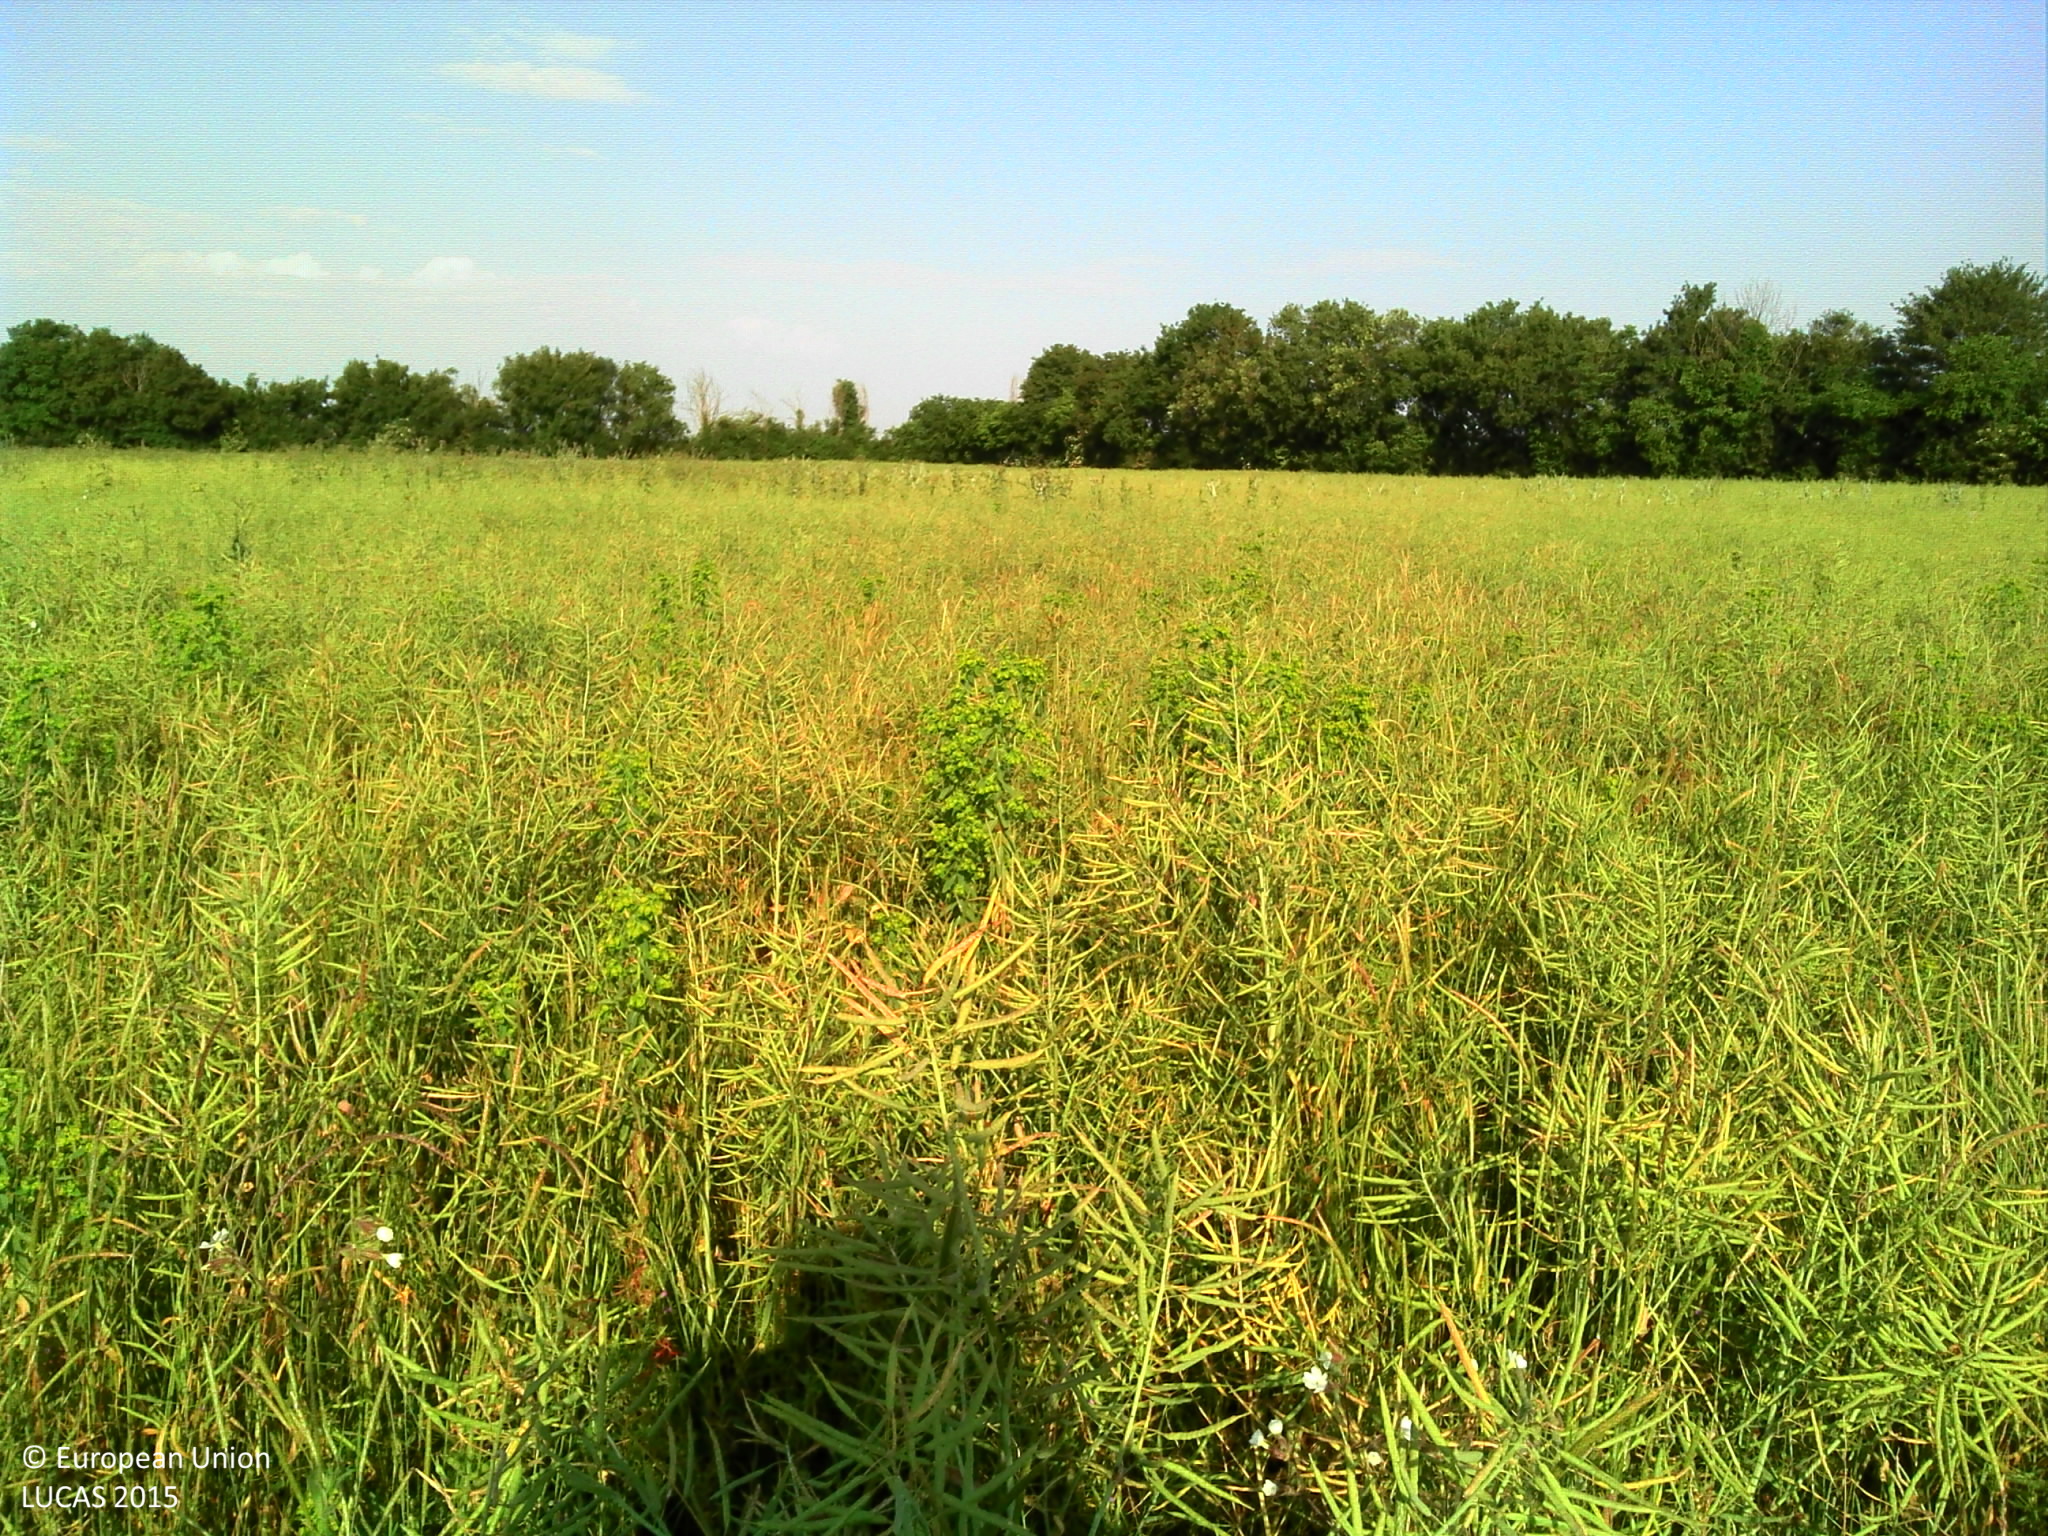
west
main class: Cropland
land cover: Common wheat
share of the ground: > 75 %
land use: Agriculture (excluding fallow land and kitchen gardens)
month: June
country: FR
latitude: 46.7418
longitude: 2.8102
